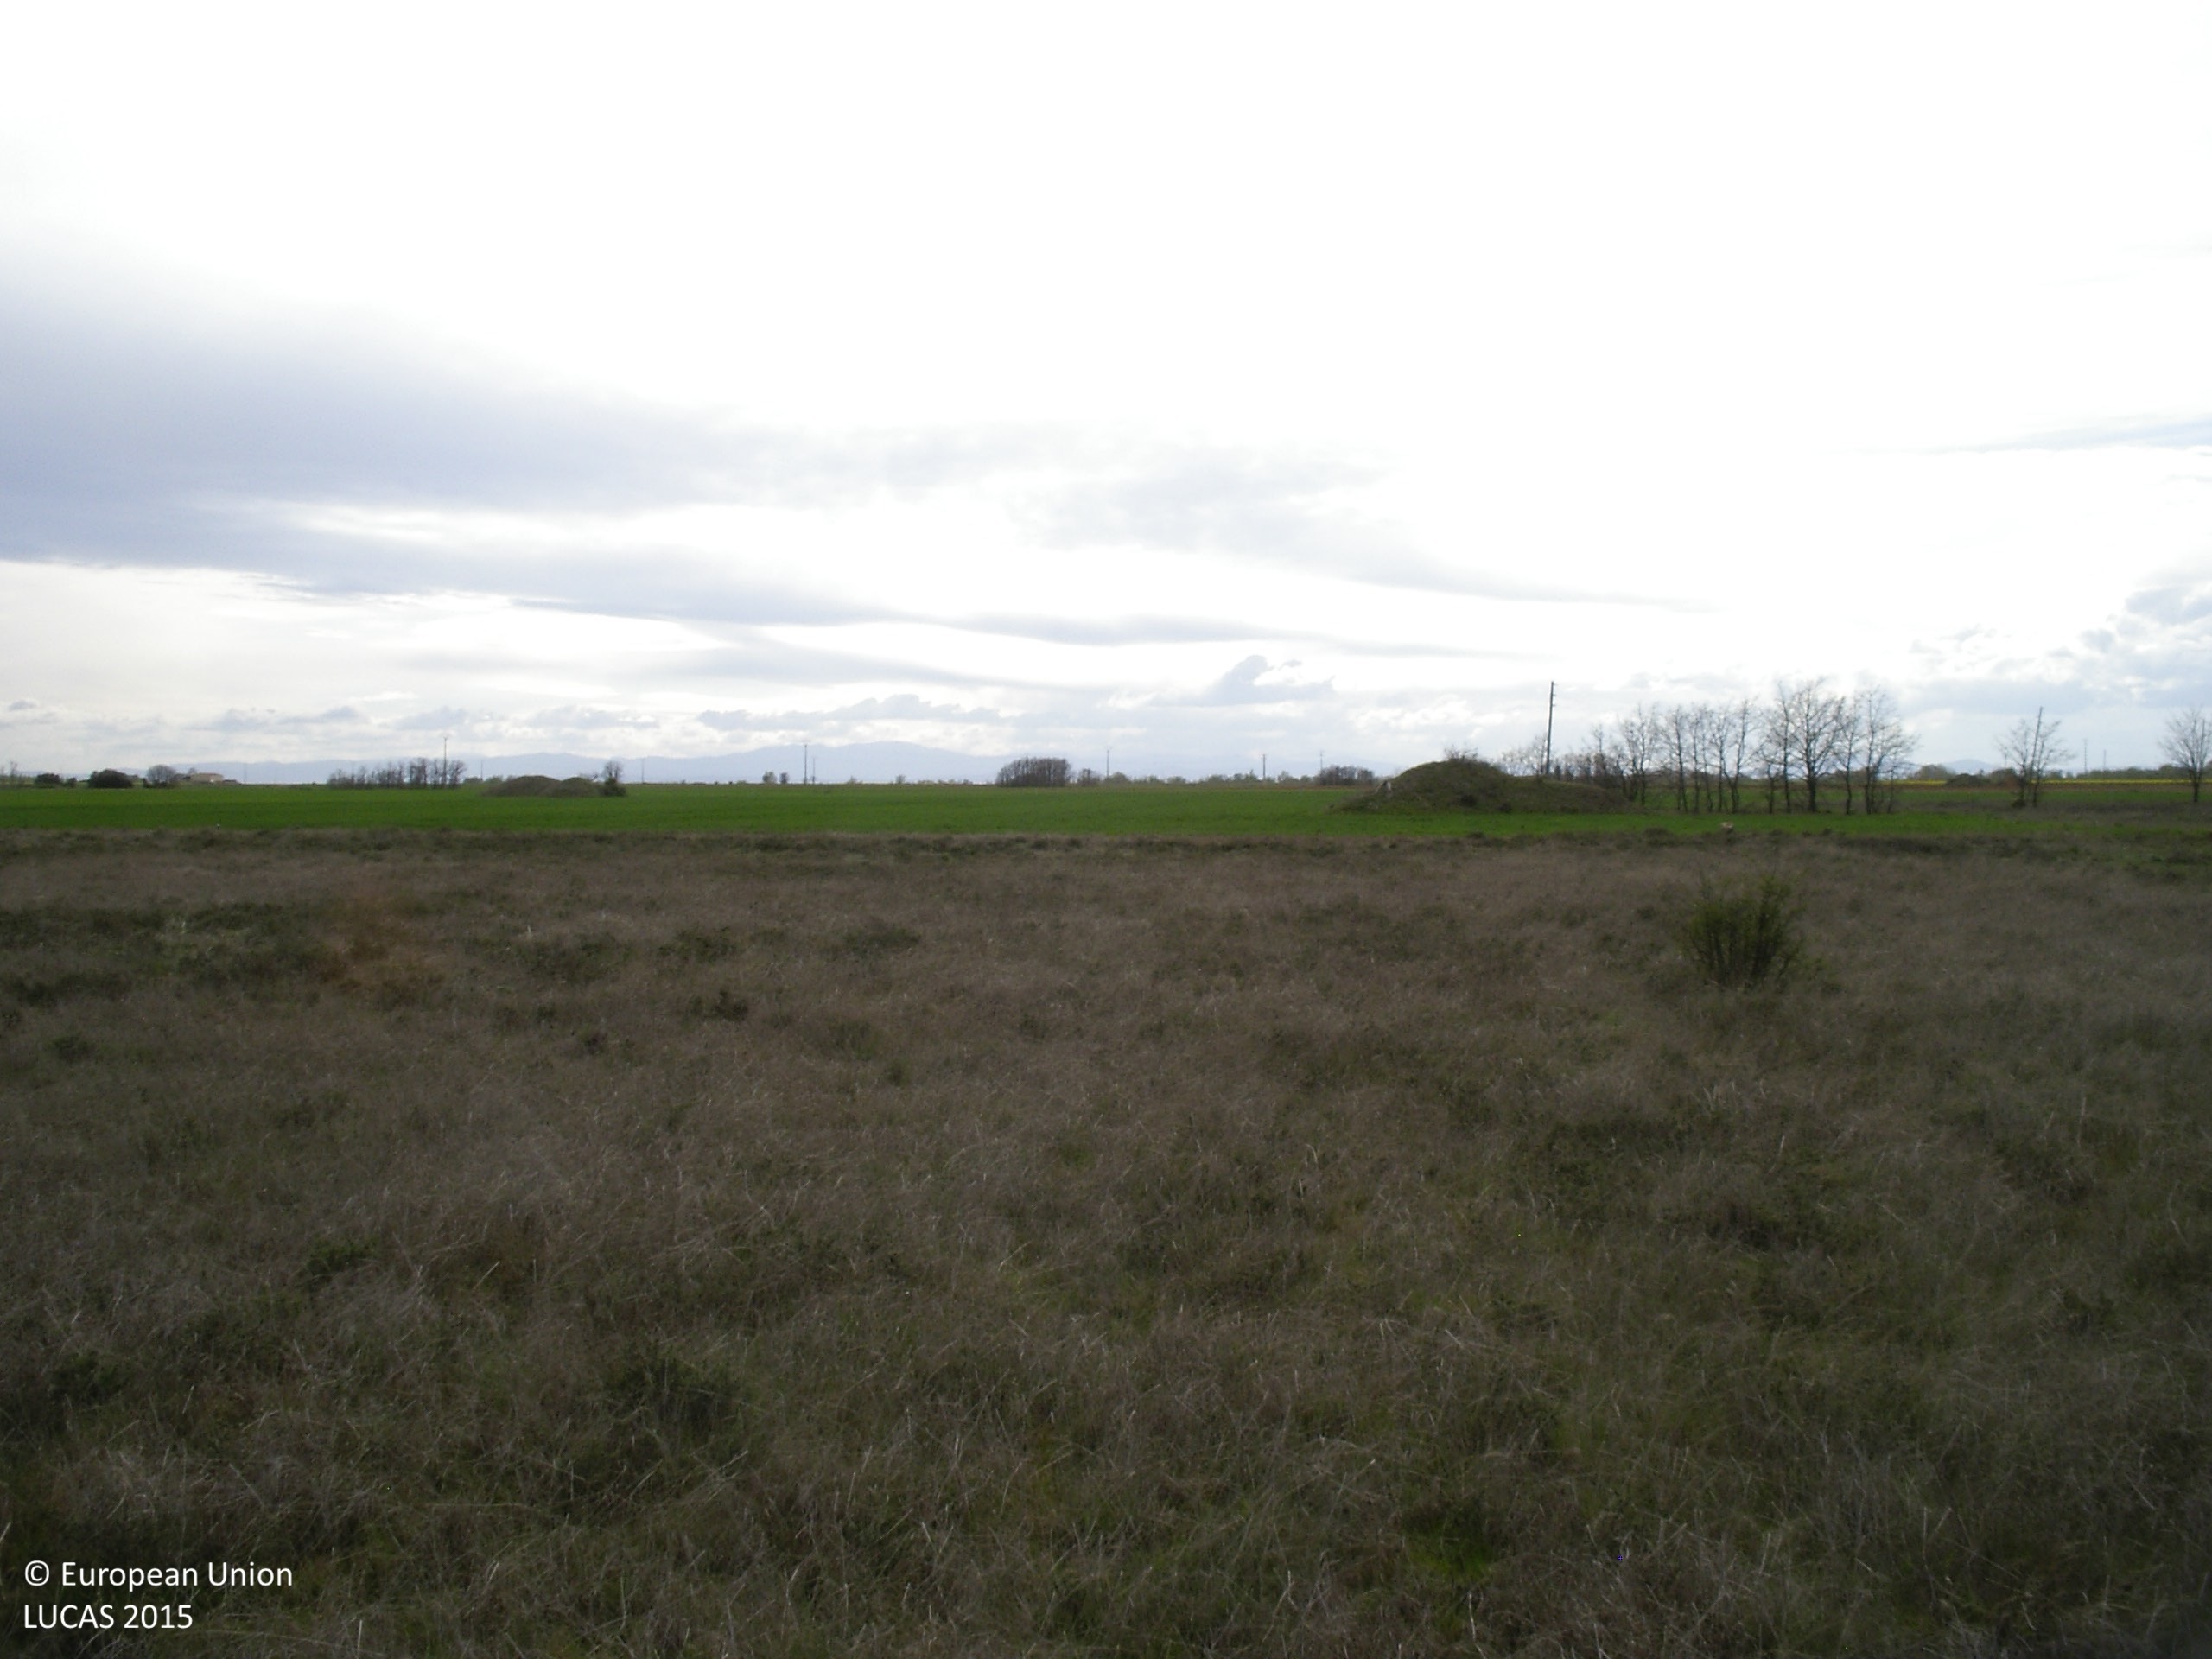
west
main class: Grassland
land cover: Grassland with sparse tree/shrub cover
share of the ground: > 75 %
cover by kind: herbaceous plants 95 %, coniferous forest trees 5 %
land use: Abandoned areas
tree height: < 5 m
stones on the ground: < 10 %
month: April
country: ES
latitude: 42.5023
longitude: -5.7117
